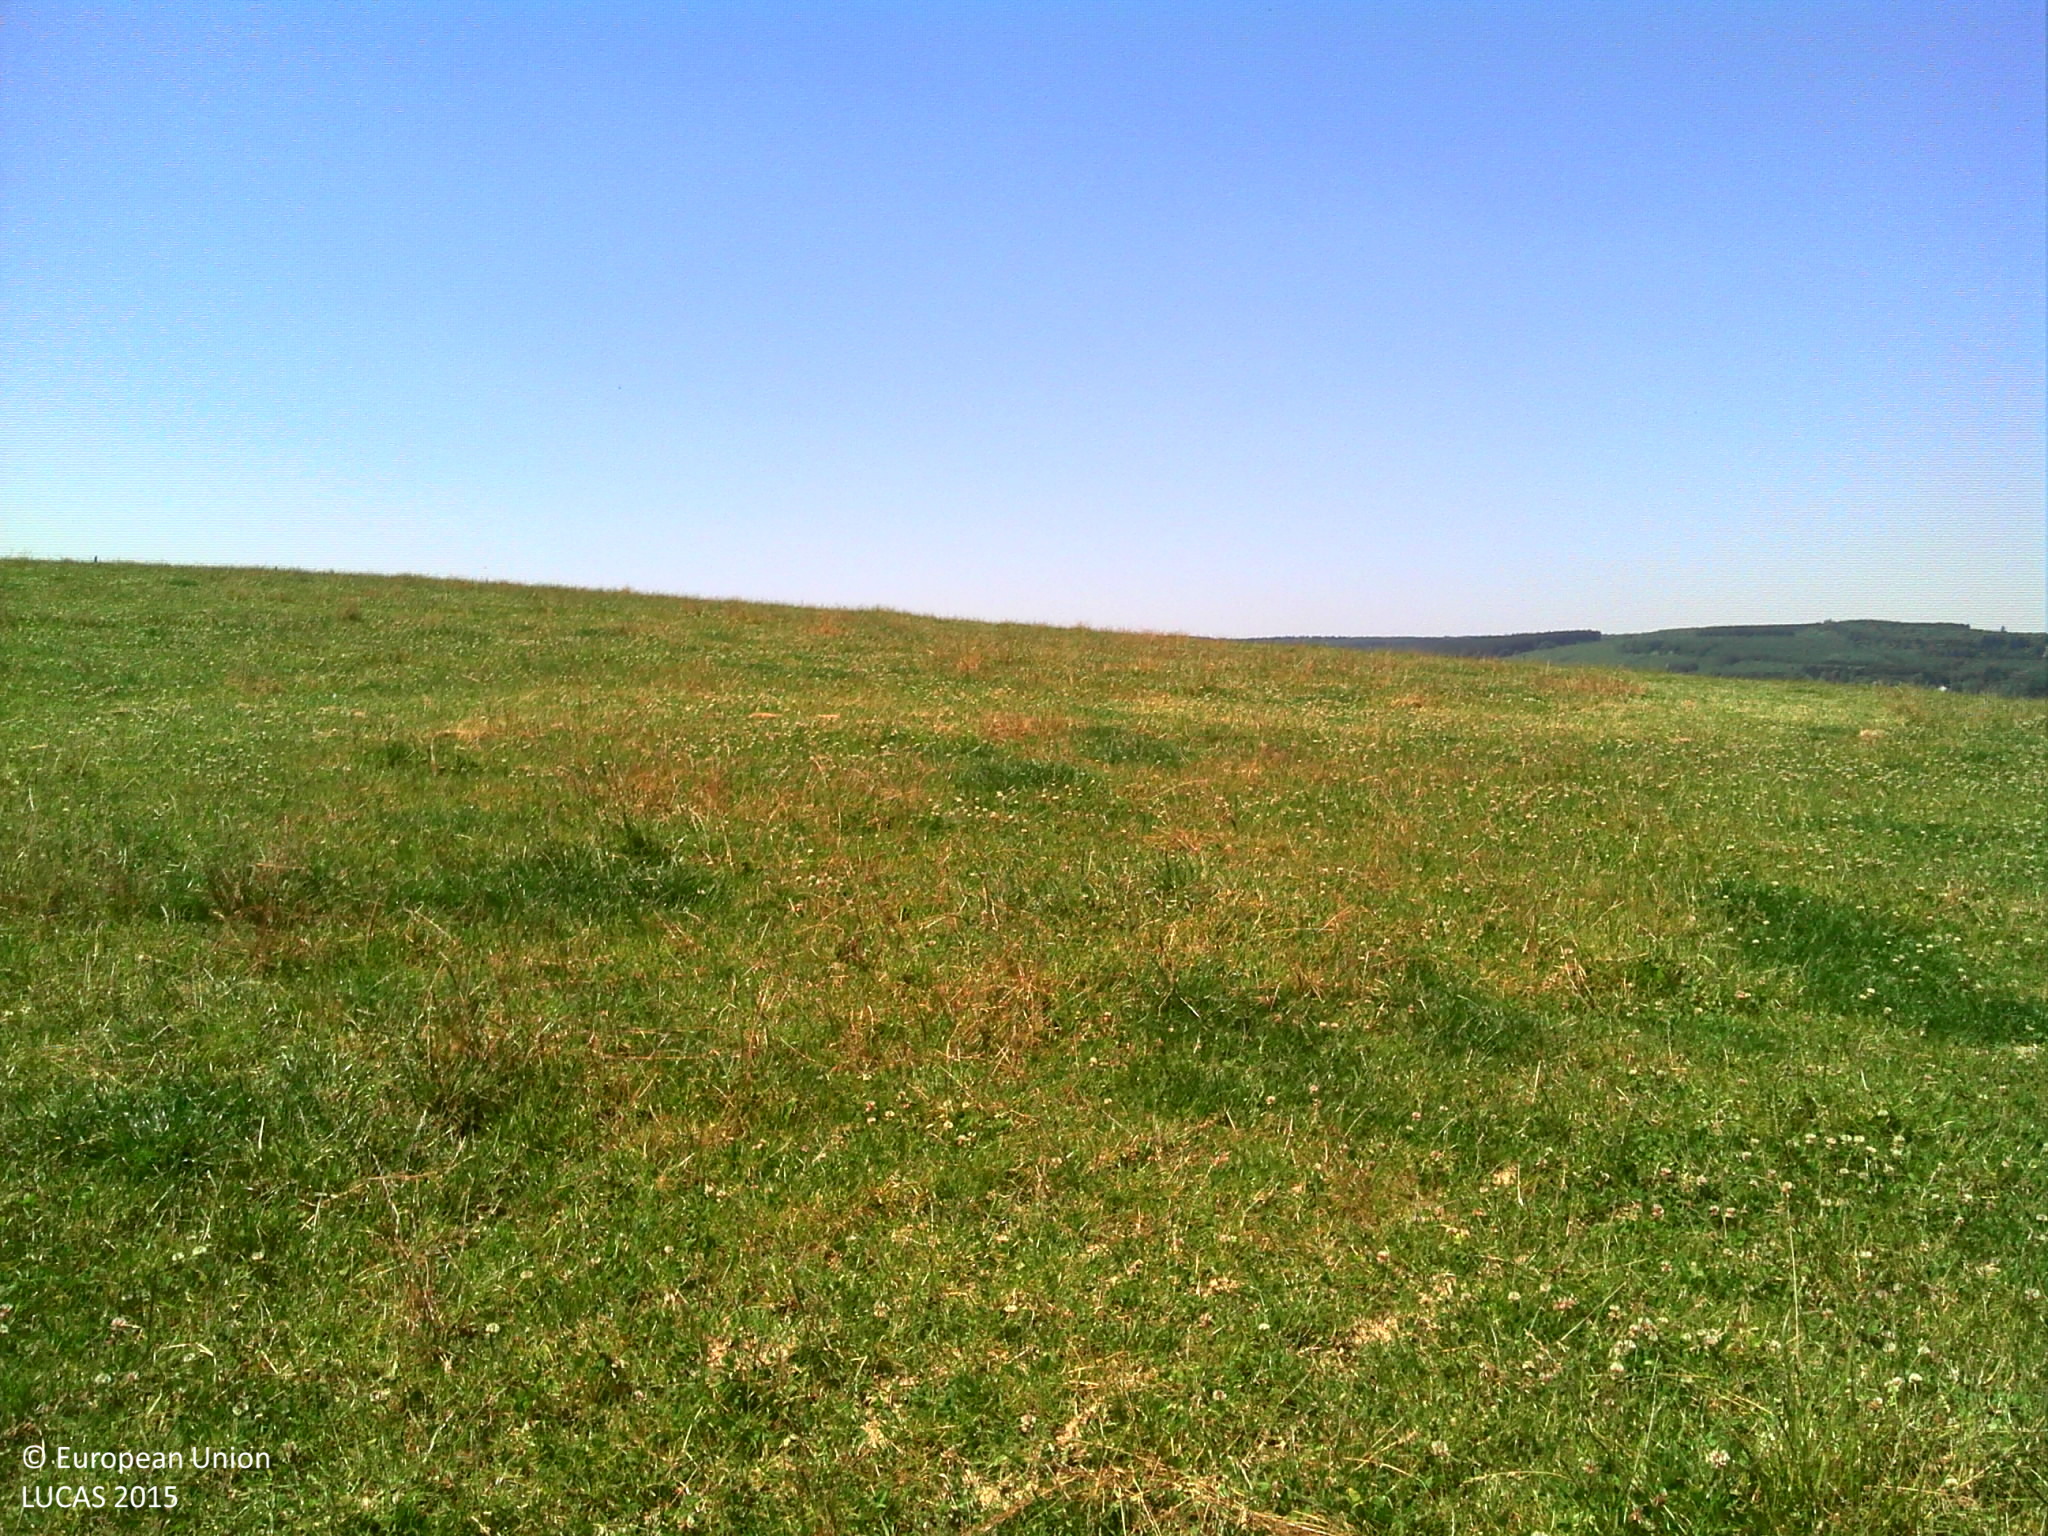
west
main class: Grassland
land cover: Grassland without tree/shrub cover
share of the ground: > 75 %
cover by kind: herbaceous plants 100 %
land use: Agriculture (excluding fallow land and kitchen gardens)
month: June
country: BE
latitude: 50.0252
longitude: 5.5457
